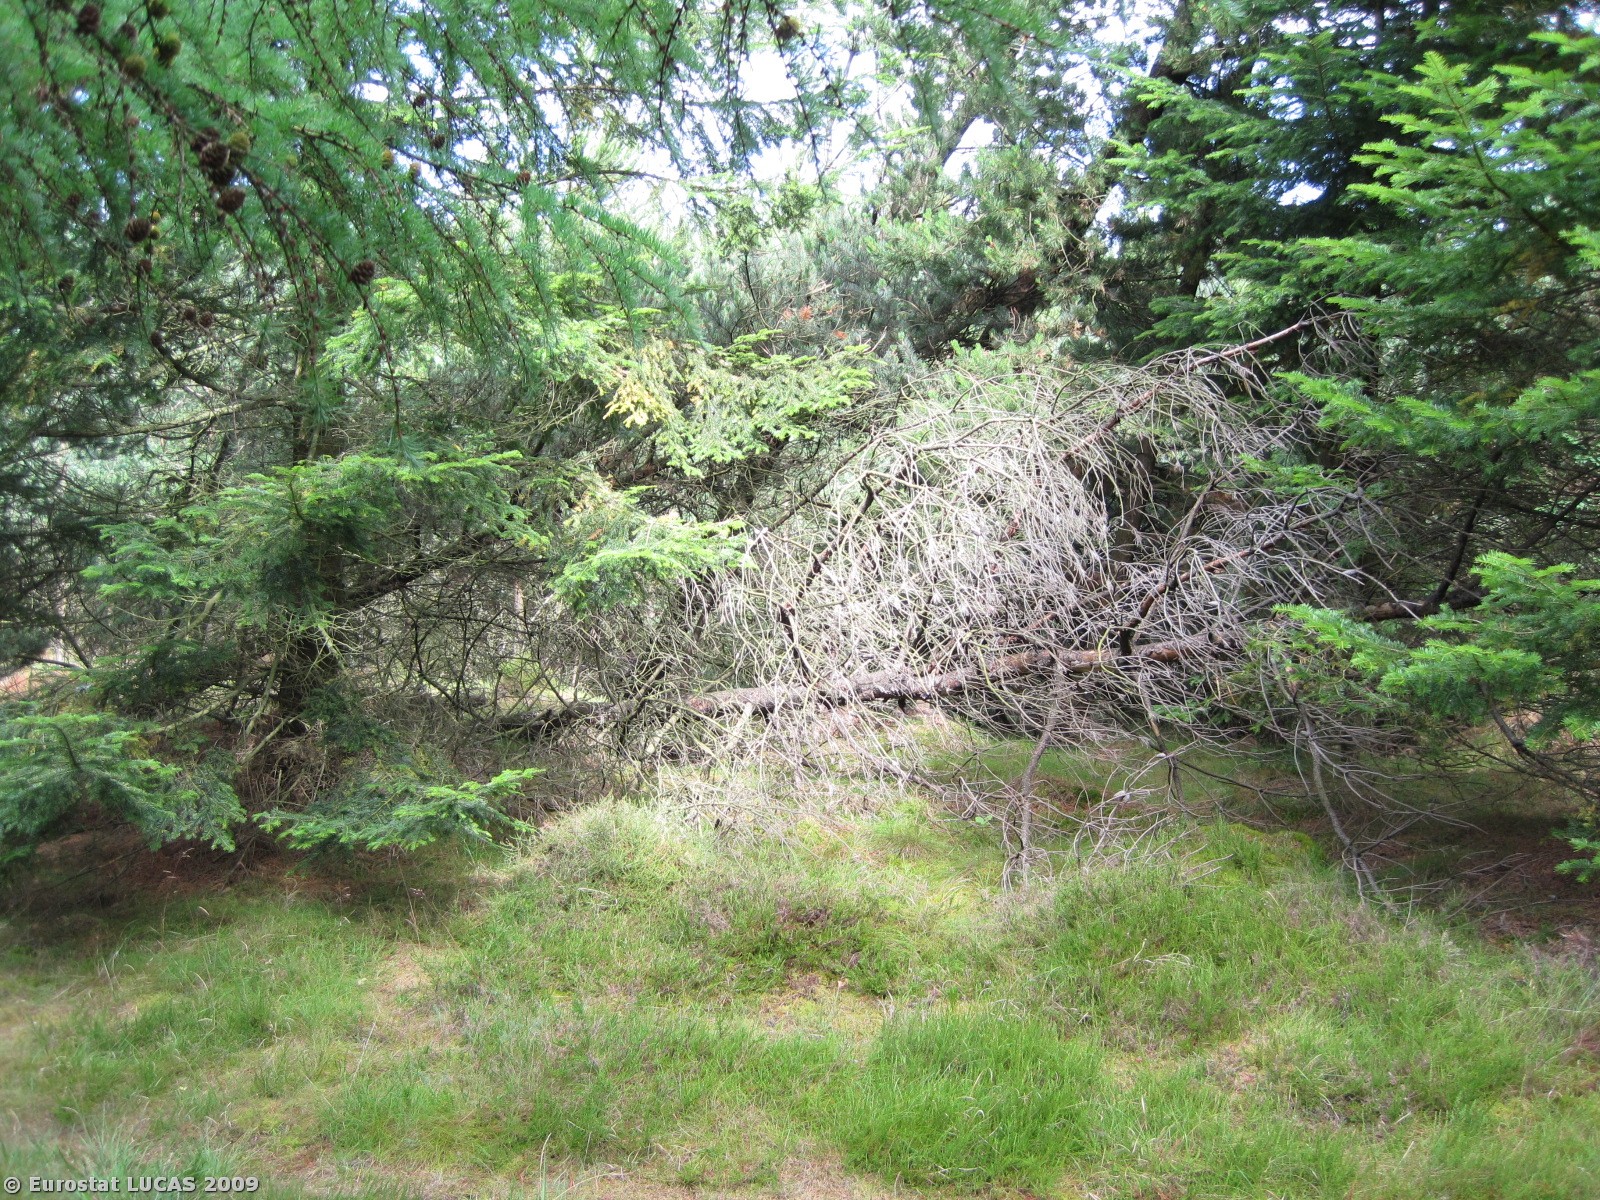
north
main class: Woodland
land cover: Coniferous woodland
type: plantations and self-sown exotic forest
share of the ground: 50 - 75 %
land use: Forestry
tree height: > 5 m
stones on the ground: < 10 %
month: July
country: DK
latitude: 57.0825
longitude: 8.9621
